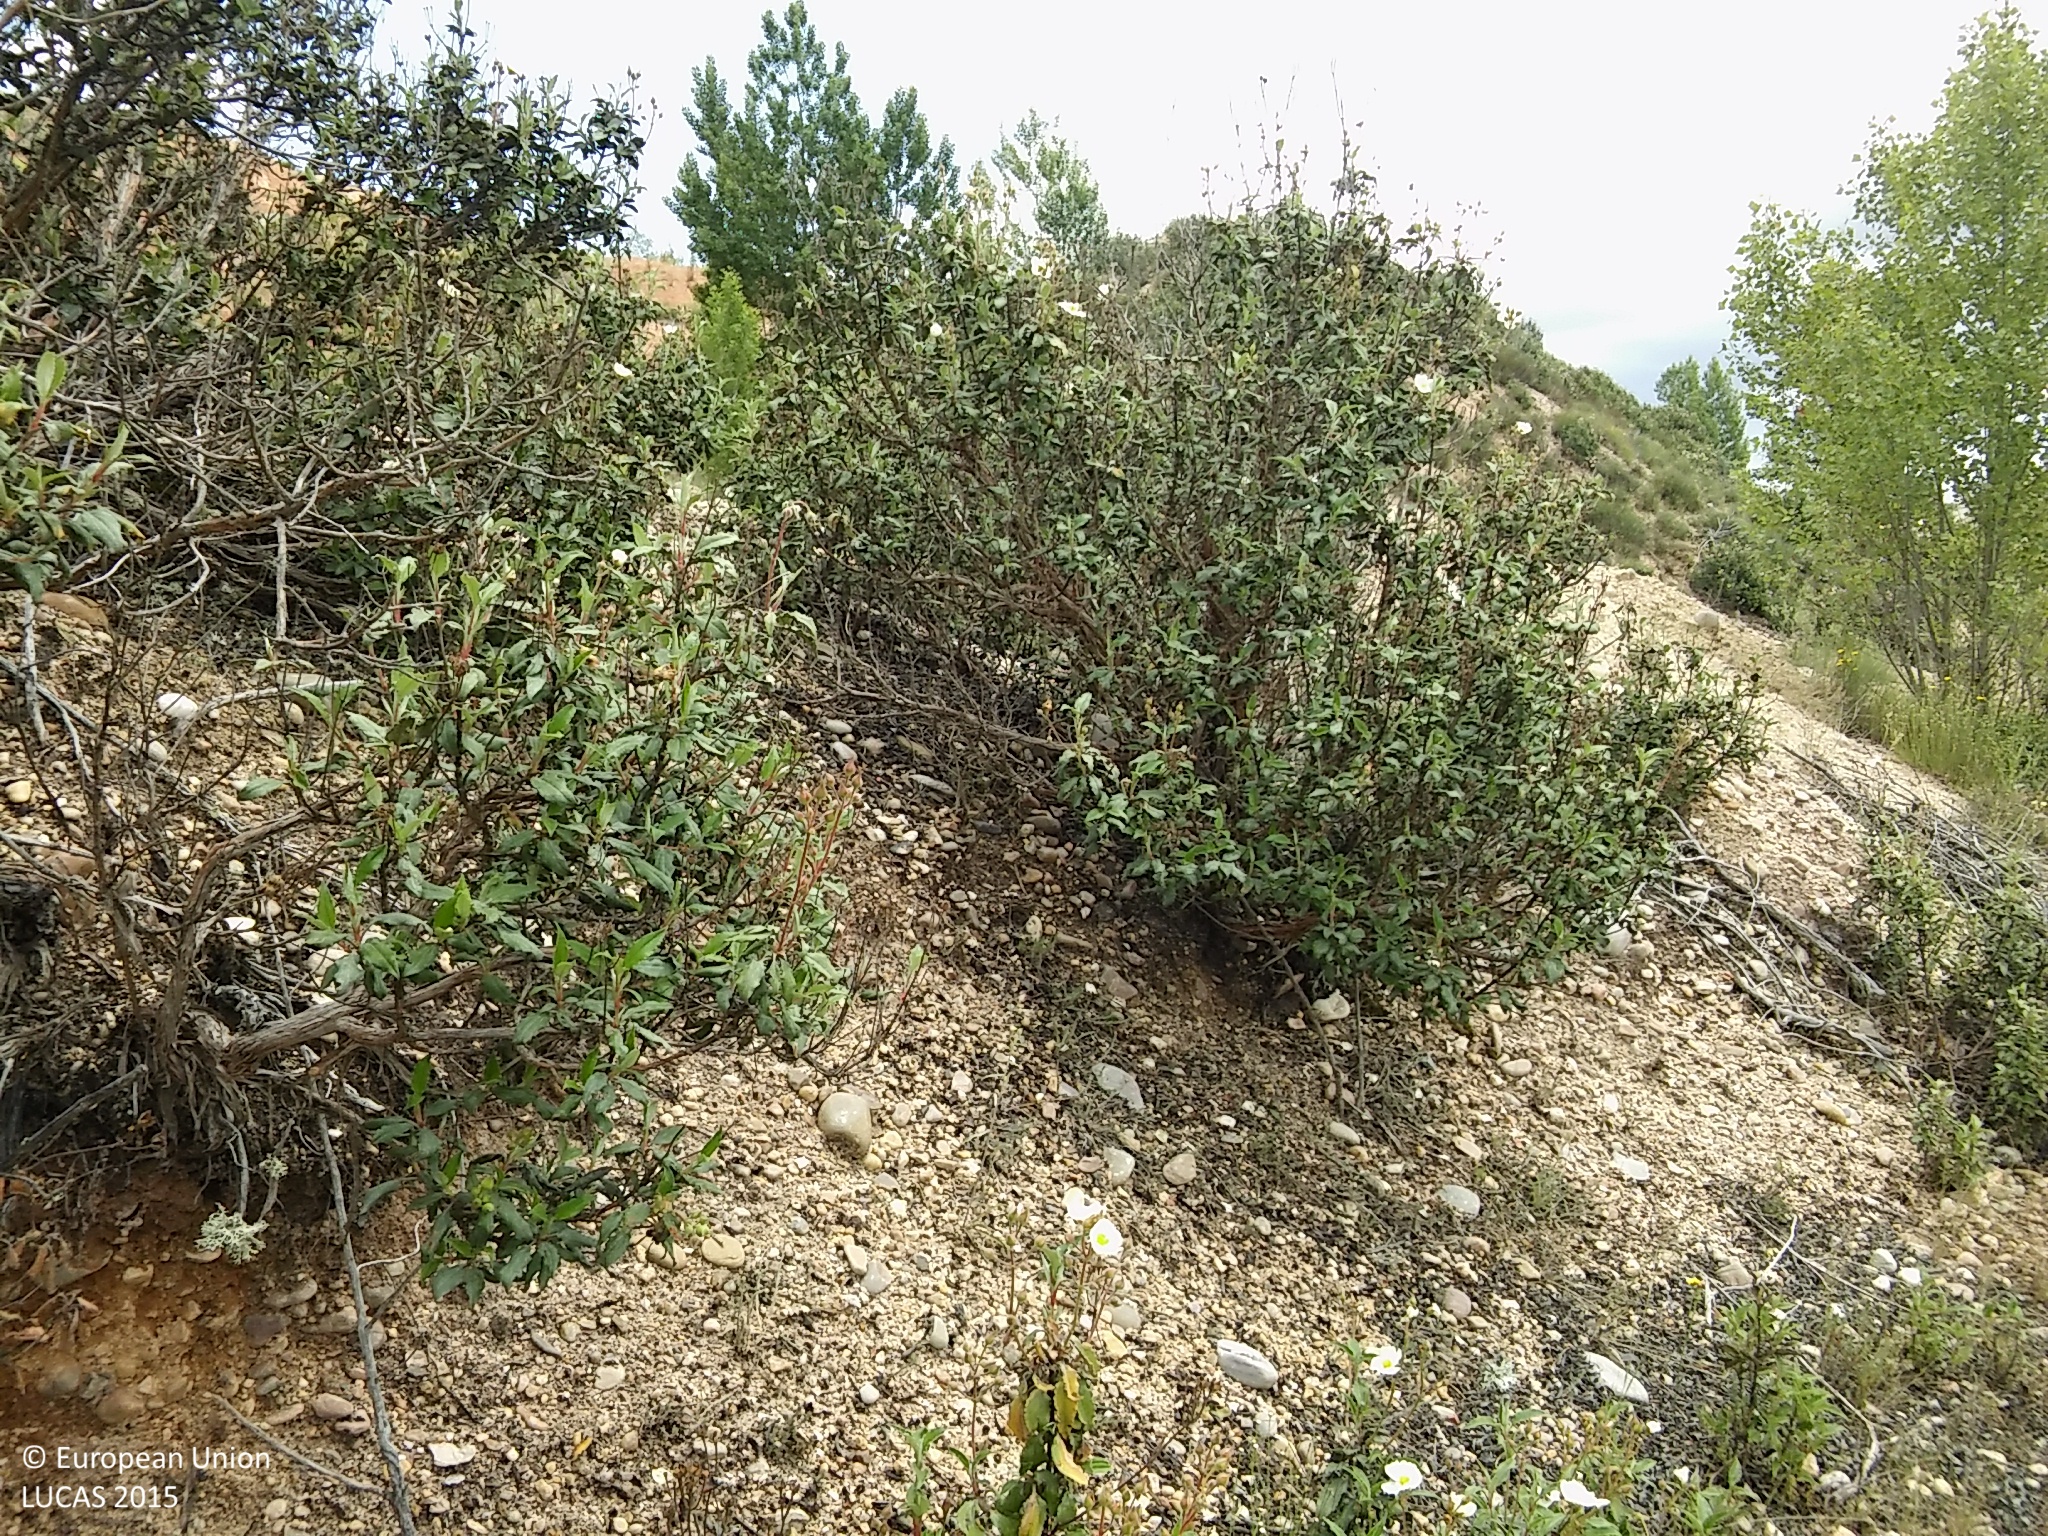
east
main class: Shrubland
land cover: Shrubland with sparse tree cover
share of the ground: 50 - 75 %
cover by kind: shrubs 50 %, unconsolidated bare surface 30 %, herbaceous plants 15 %, coniferous forest trees 5 %
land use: Semi-natural and natural areas not in use
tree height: > 5 m
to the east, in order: Shrubland with sparse tree cover; Artificial constructions in urban areas
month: June
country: ES
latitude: 41.4460
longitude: -3.6834
